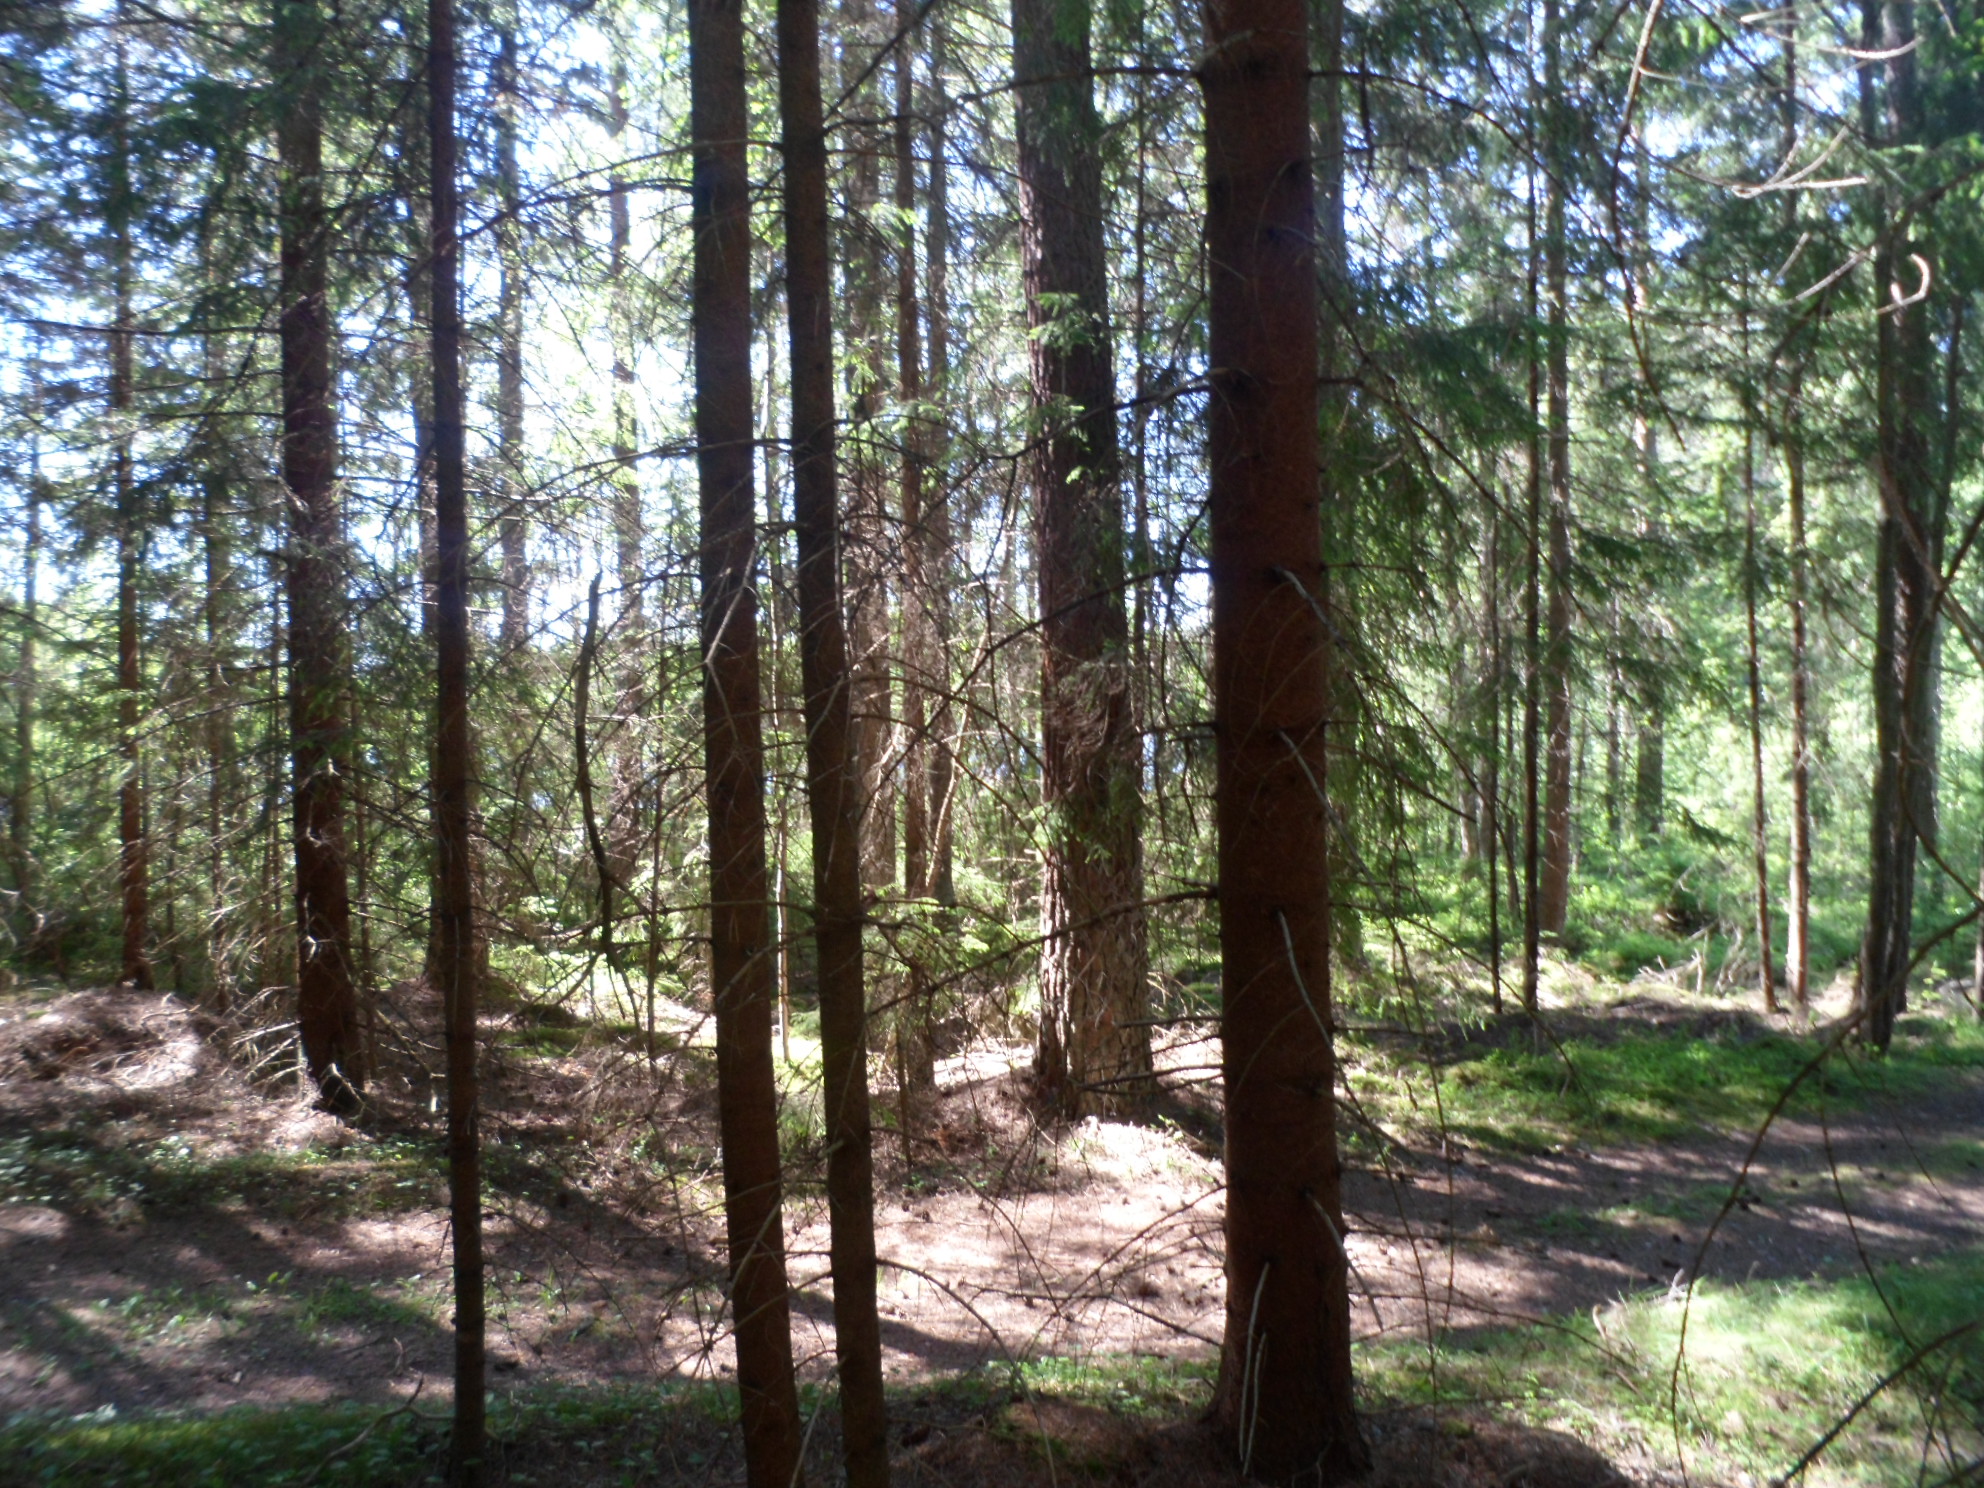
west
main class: Woodland
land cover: Spruce dominated coniferous woodland
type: boreal forest
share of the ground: 50 - 75 %
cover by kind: coniferous forest trees 65 %, lichens and mosses 15 %, unconsolidated bare surface 15 %, herbaceous plants 5 %
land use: Forestry
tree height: > 5 m
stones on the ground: < 10 %
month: July
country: SE
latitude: 57.1879
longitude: 14.5465
